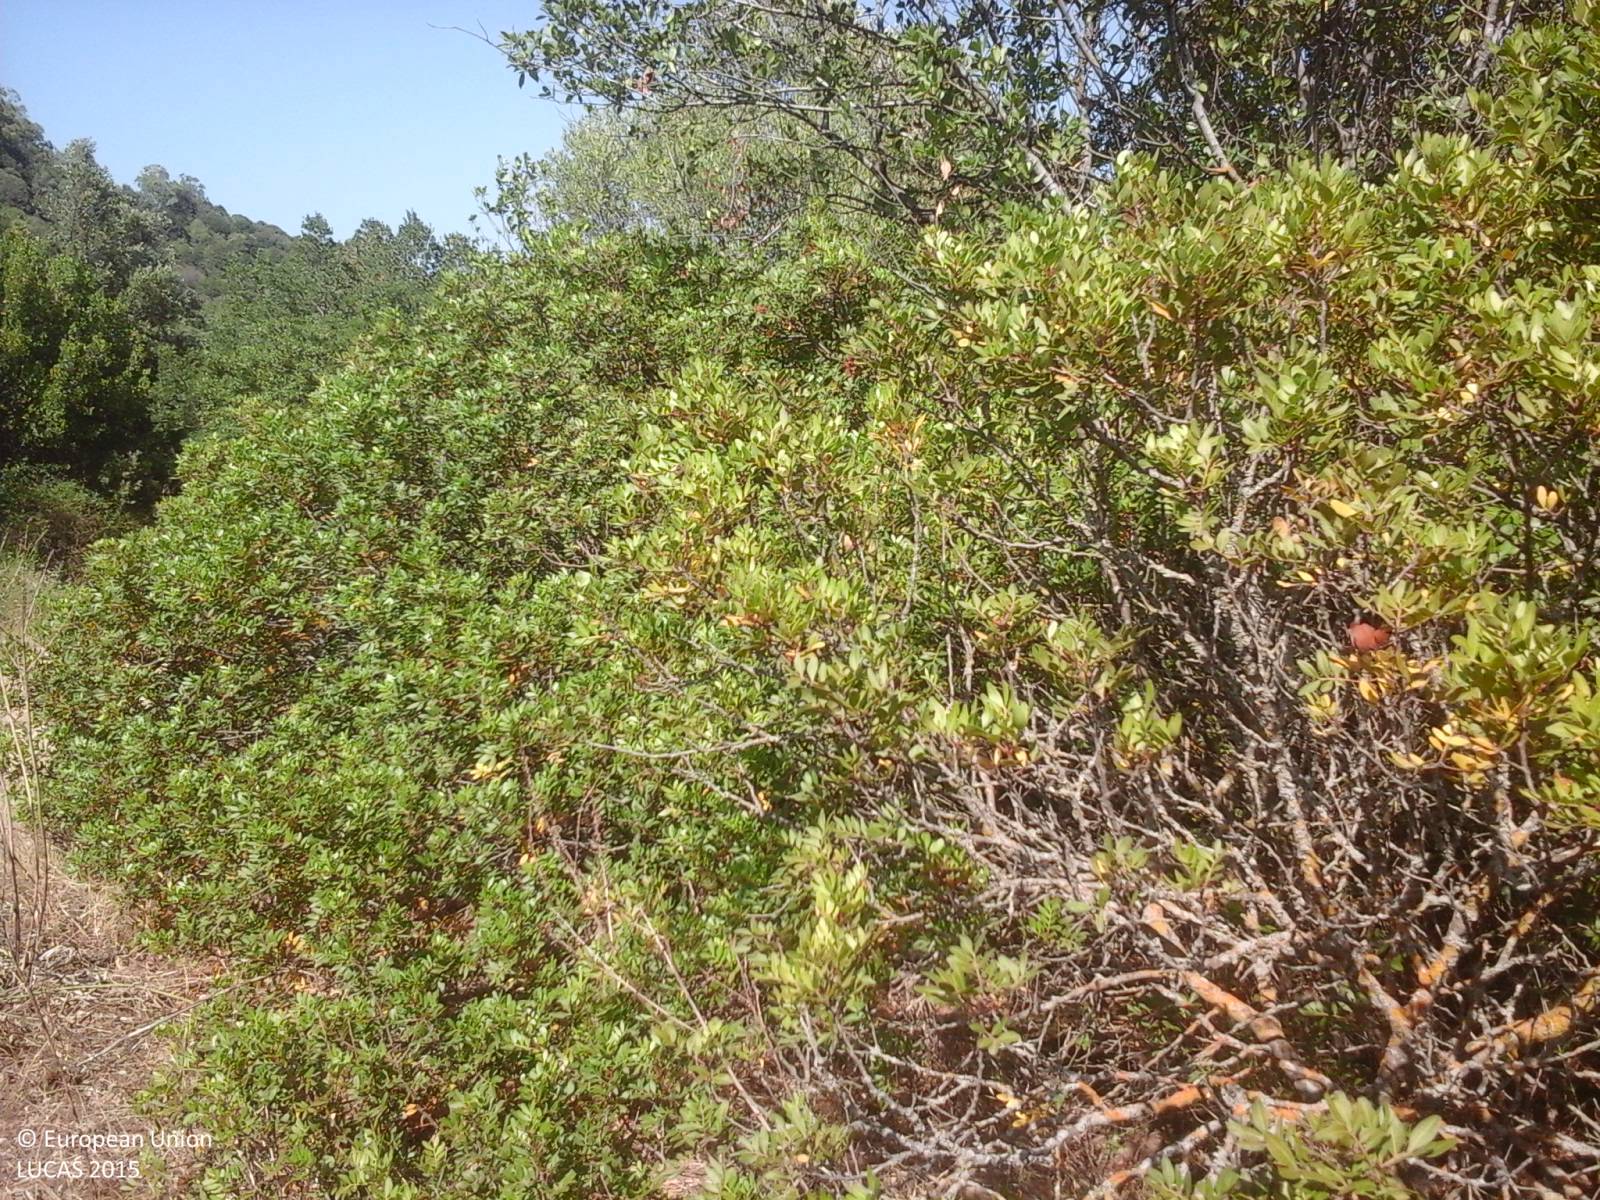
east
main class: Shrubland
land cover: Shrubland with sparse tree cover
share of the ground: > 75 %
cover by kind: shrubs 95 %, broadleaved forest trees 5 %
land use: Semi-natural and natural areas not in use
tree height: > 5 m
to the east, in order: Shrubland with sparse tree cover; Tracks; Shrubland with sparse tree cover; Tracks; Shrubland with sparse tree cover
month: July
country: IT
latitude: 40.7903
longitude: 9.3985
